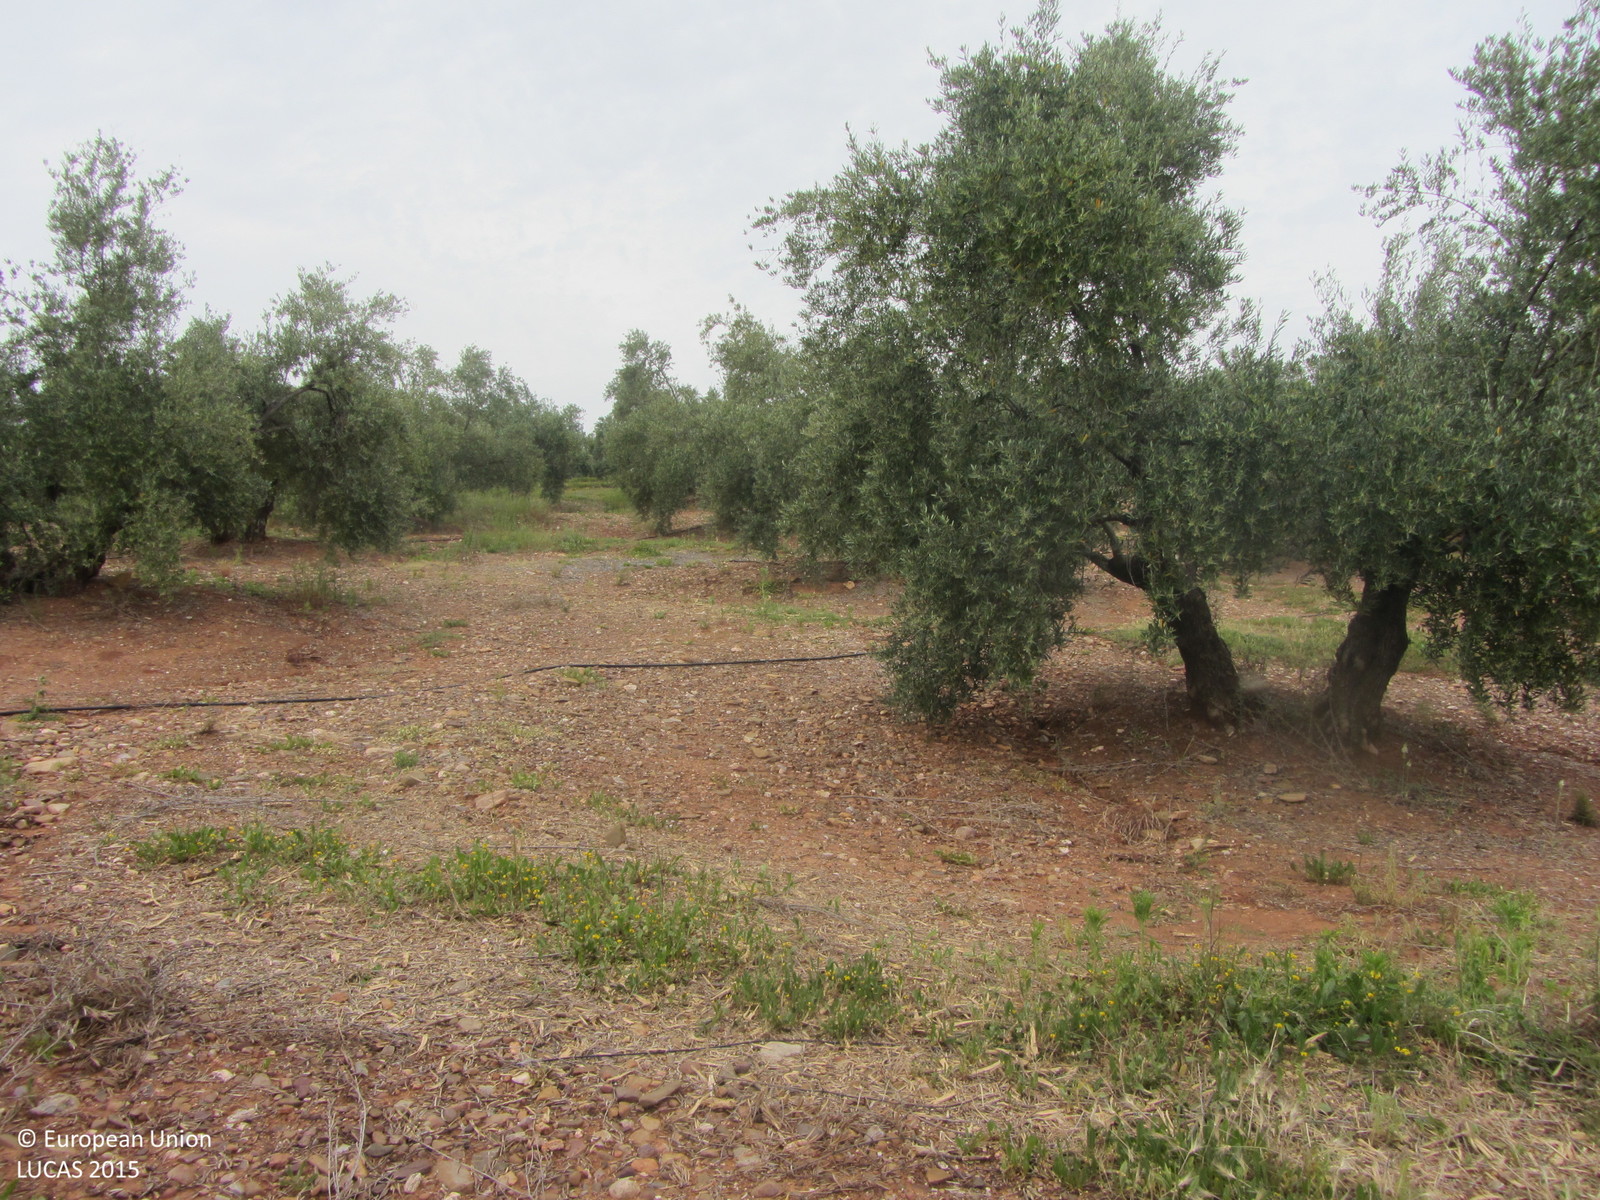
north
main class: Cropland
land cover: Olive groves
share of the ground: 25 - 50 %
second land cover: Spontaneously vegetated surfaces
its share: 50 - 75 %
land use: Agriculture (excluding fallow land and kitchen gardens)
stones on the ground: > 50 %
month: May
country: ES
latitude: 38.2636
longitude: -2.9949
